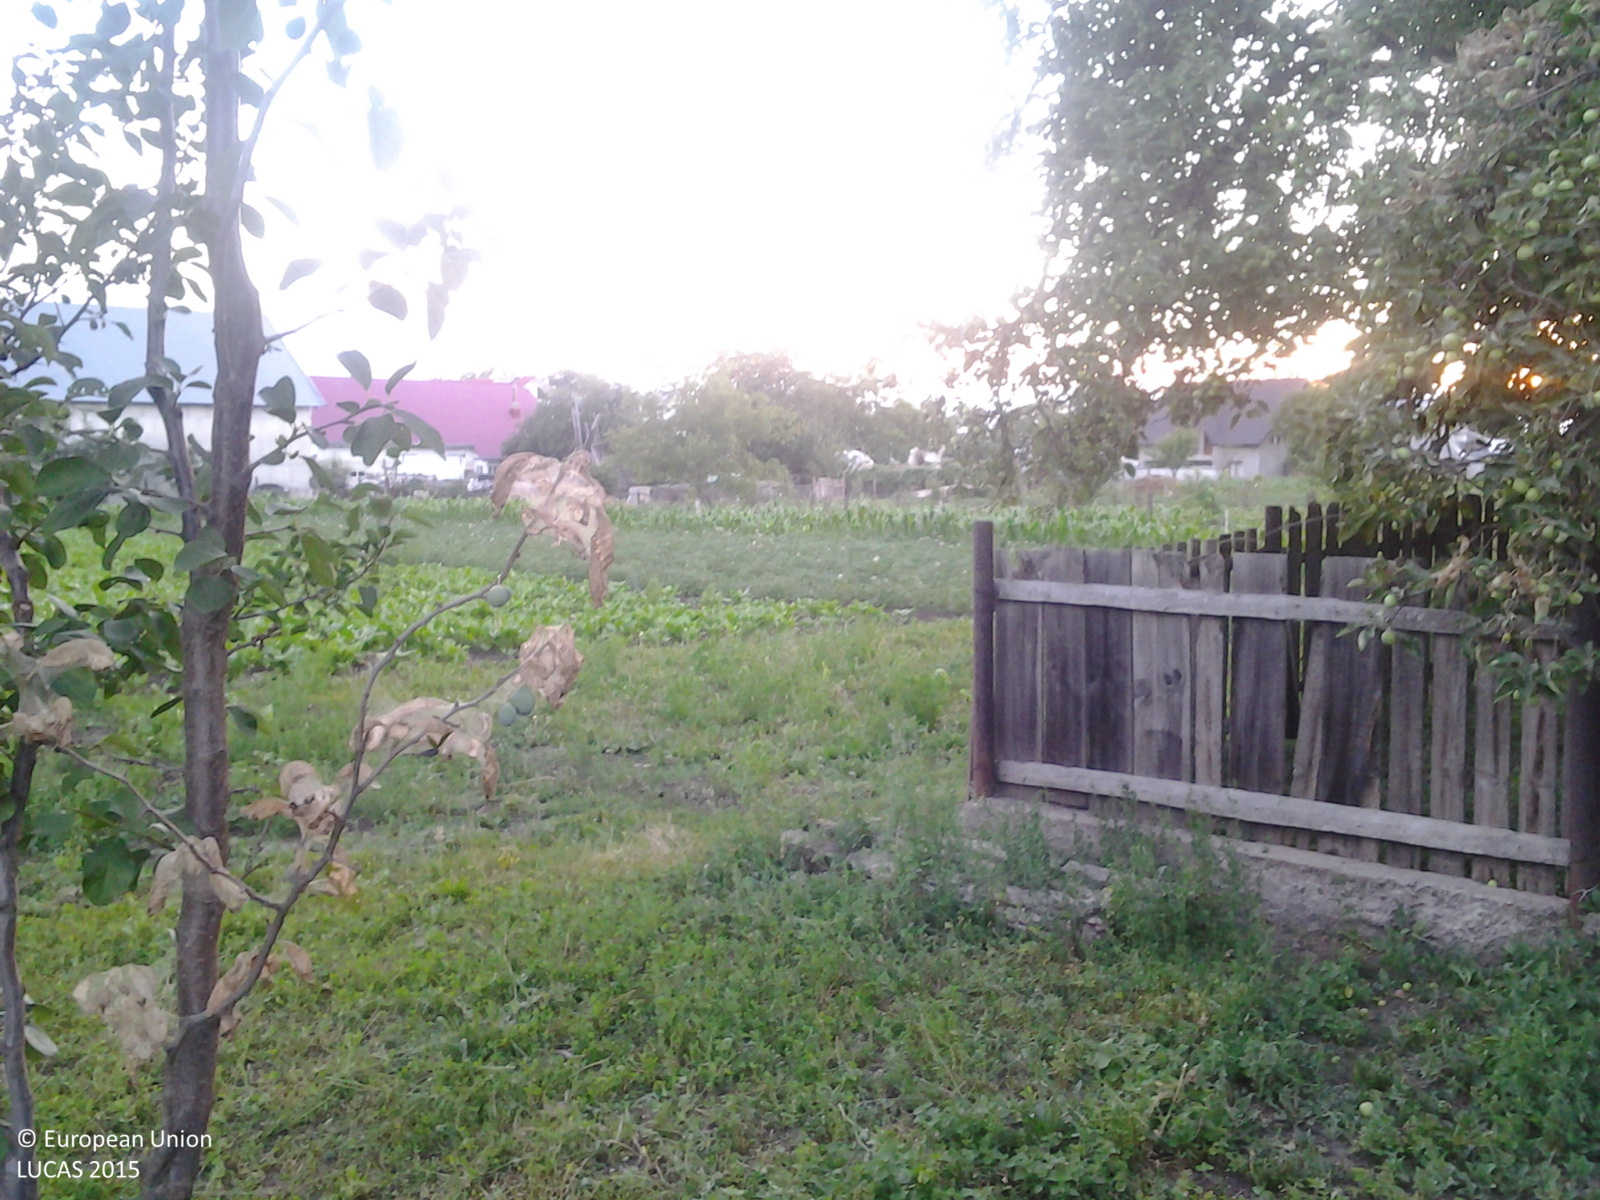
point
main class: Grassland
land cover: Grassland without tree/shrub cover
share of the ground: > 75 %
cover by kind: herbaceous plants 100 %
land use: Agriculture (excluding fallow land and kitchen gardens)
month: June
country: RO
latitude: 47.7430
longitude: 26.4807
